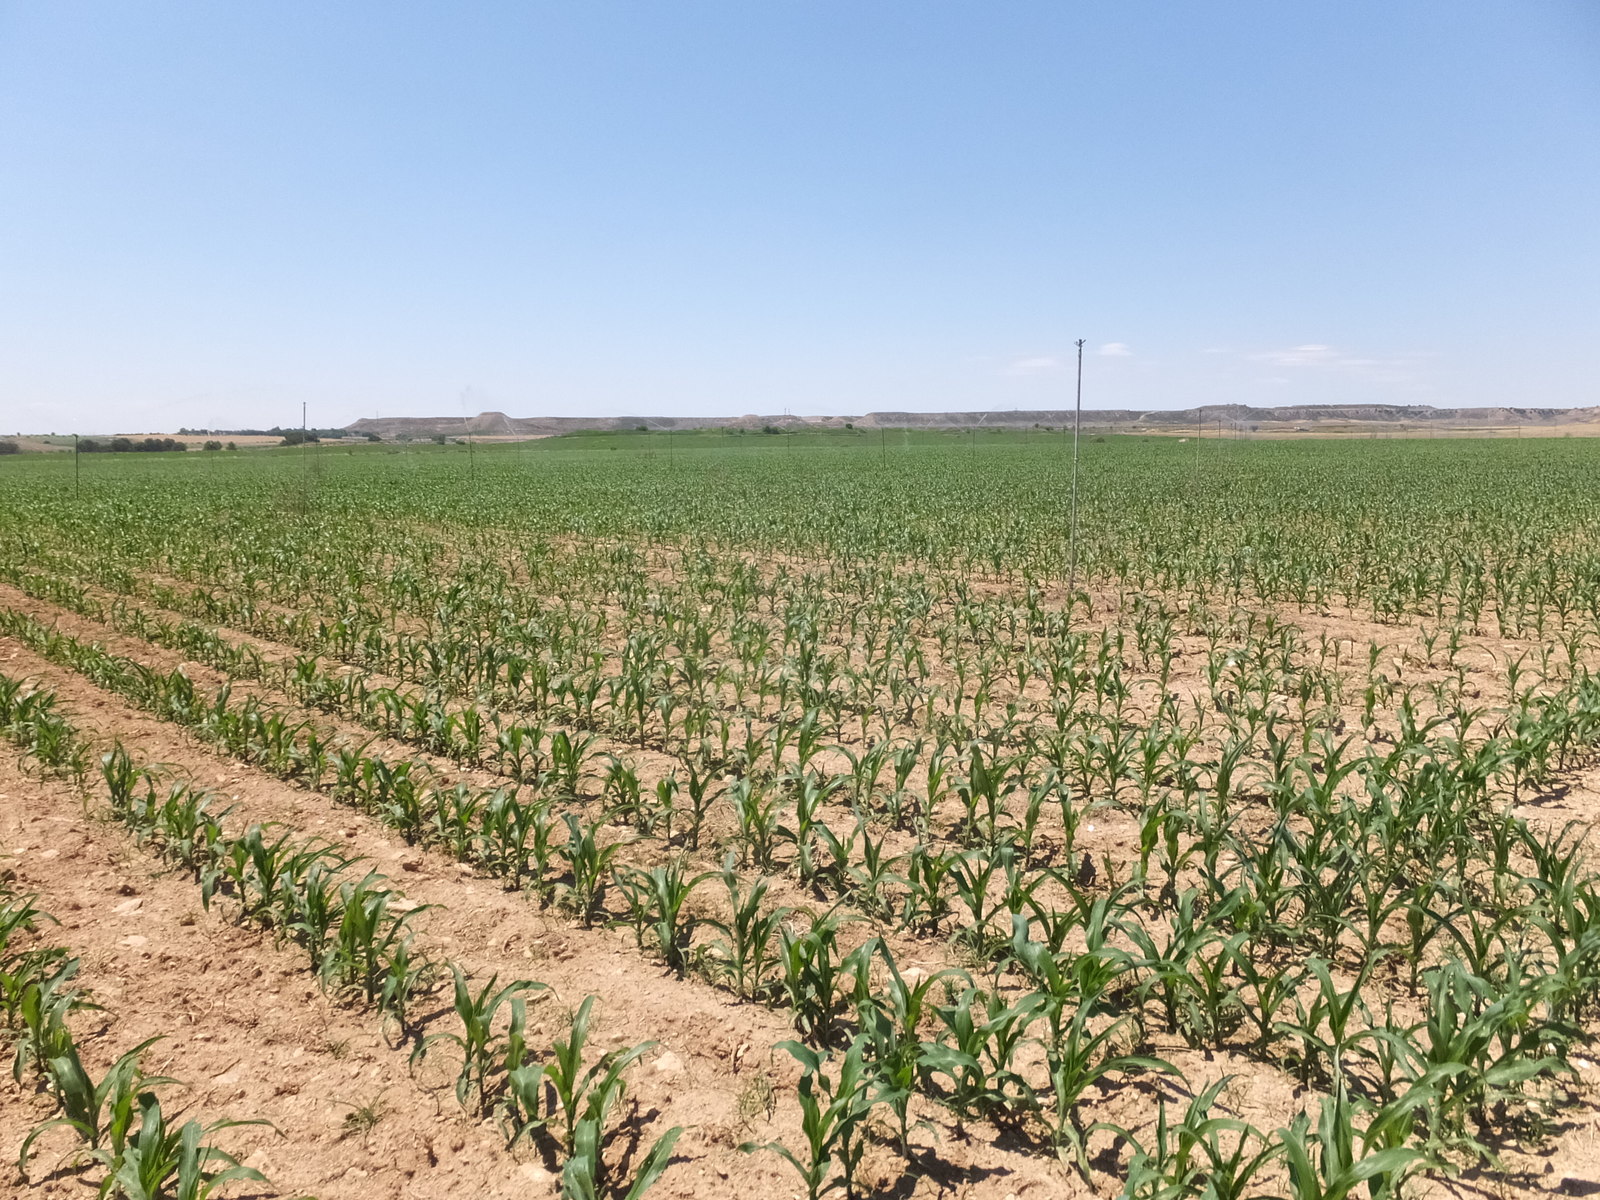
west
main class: Cropland
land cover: Maize
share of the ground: < 10 %
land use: Agriculture (excluding fallow land and kitchen gardens)
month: June
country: ES
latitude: 41.5288
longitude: 0.0742
